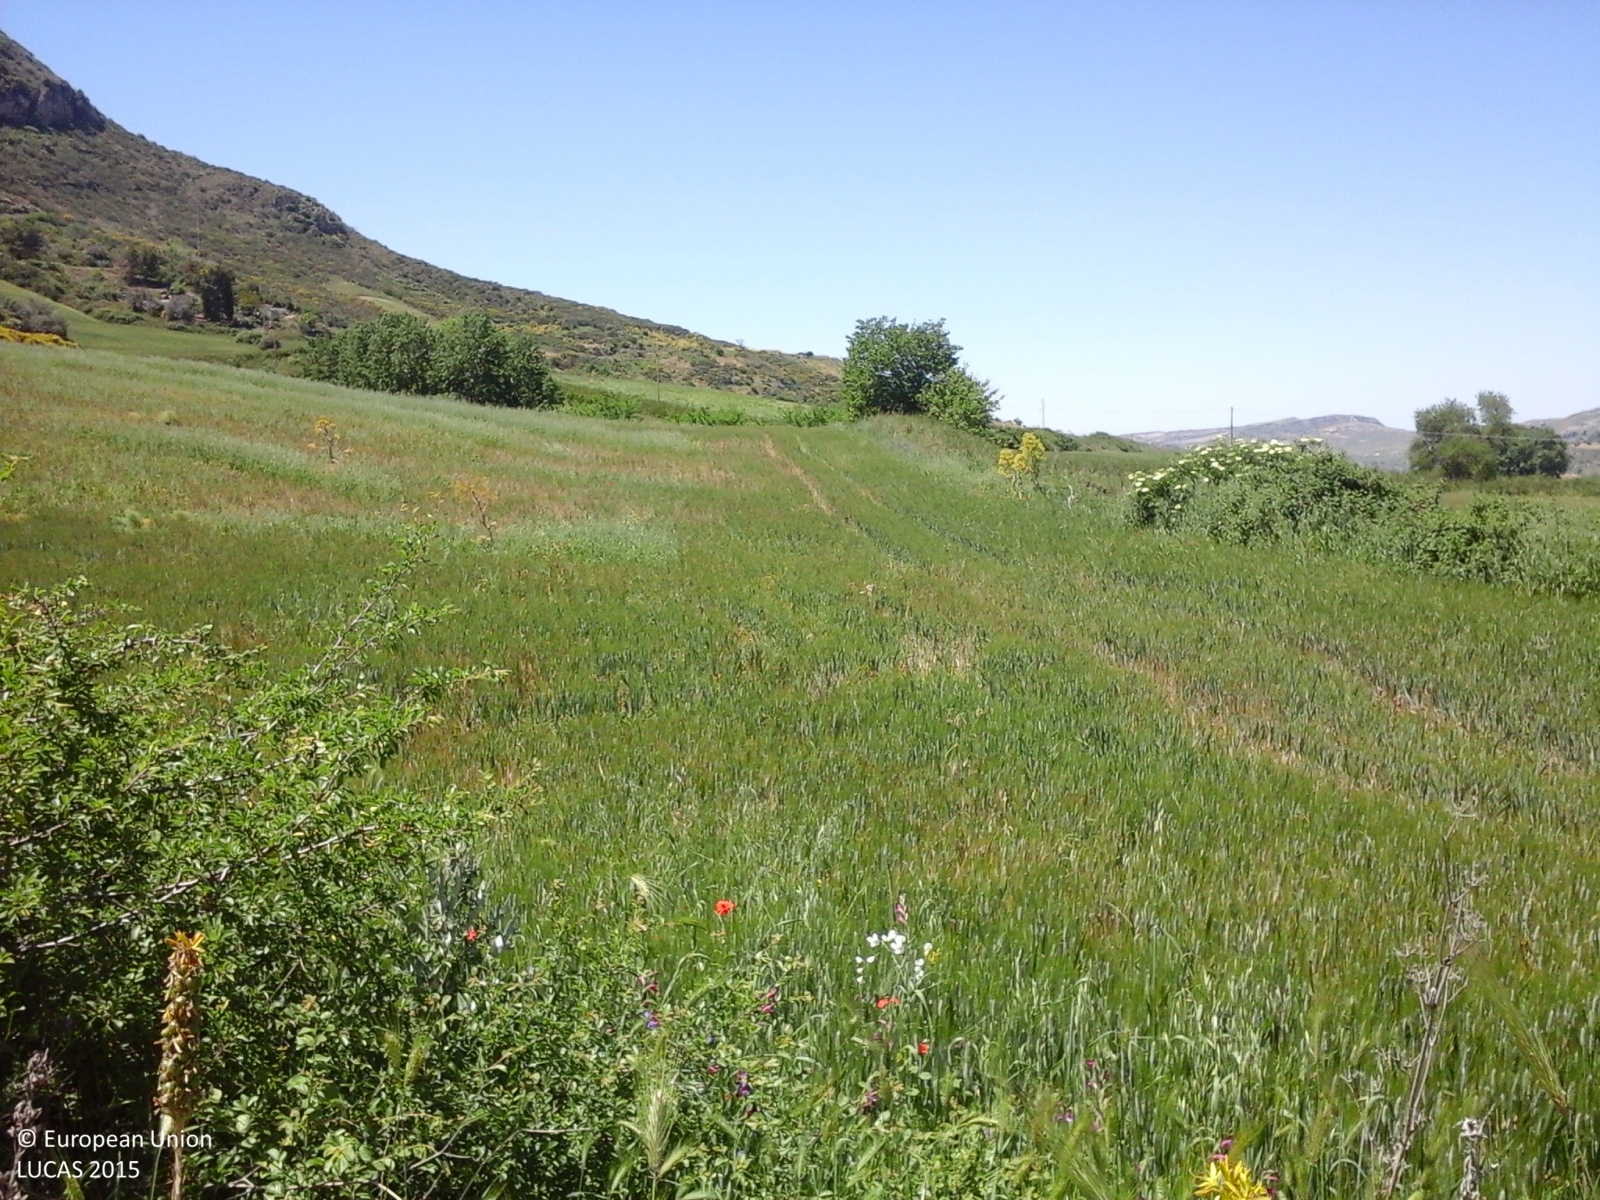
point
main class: Cropland
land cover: Durum wheat
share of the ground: > 75 %
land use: Agriculture (excluding fallow land and kitchen gardens)
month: May
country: IT
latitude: 37.5240
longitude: 14.2794
